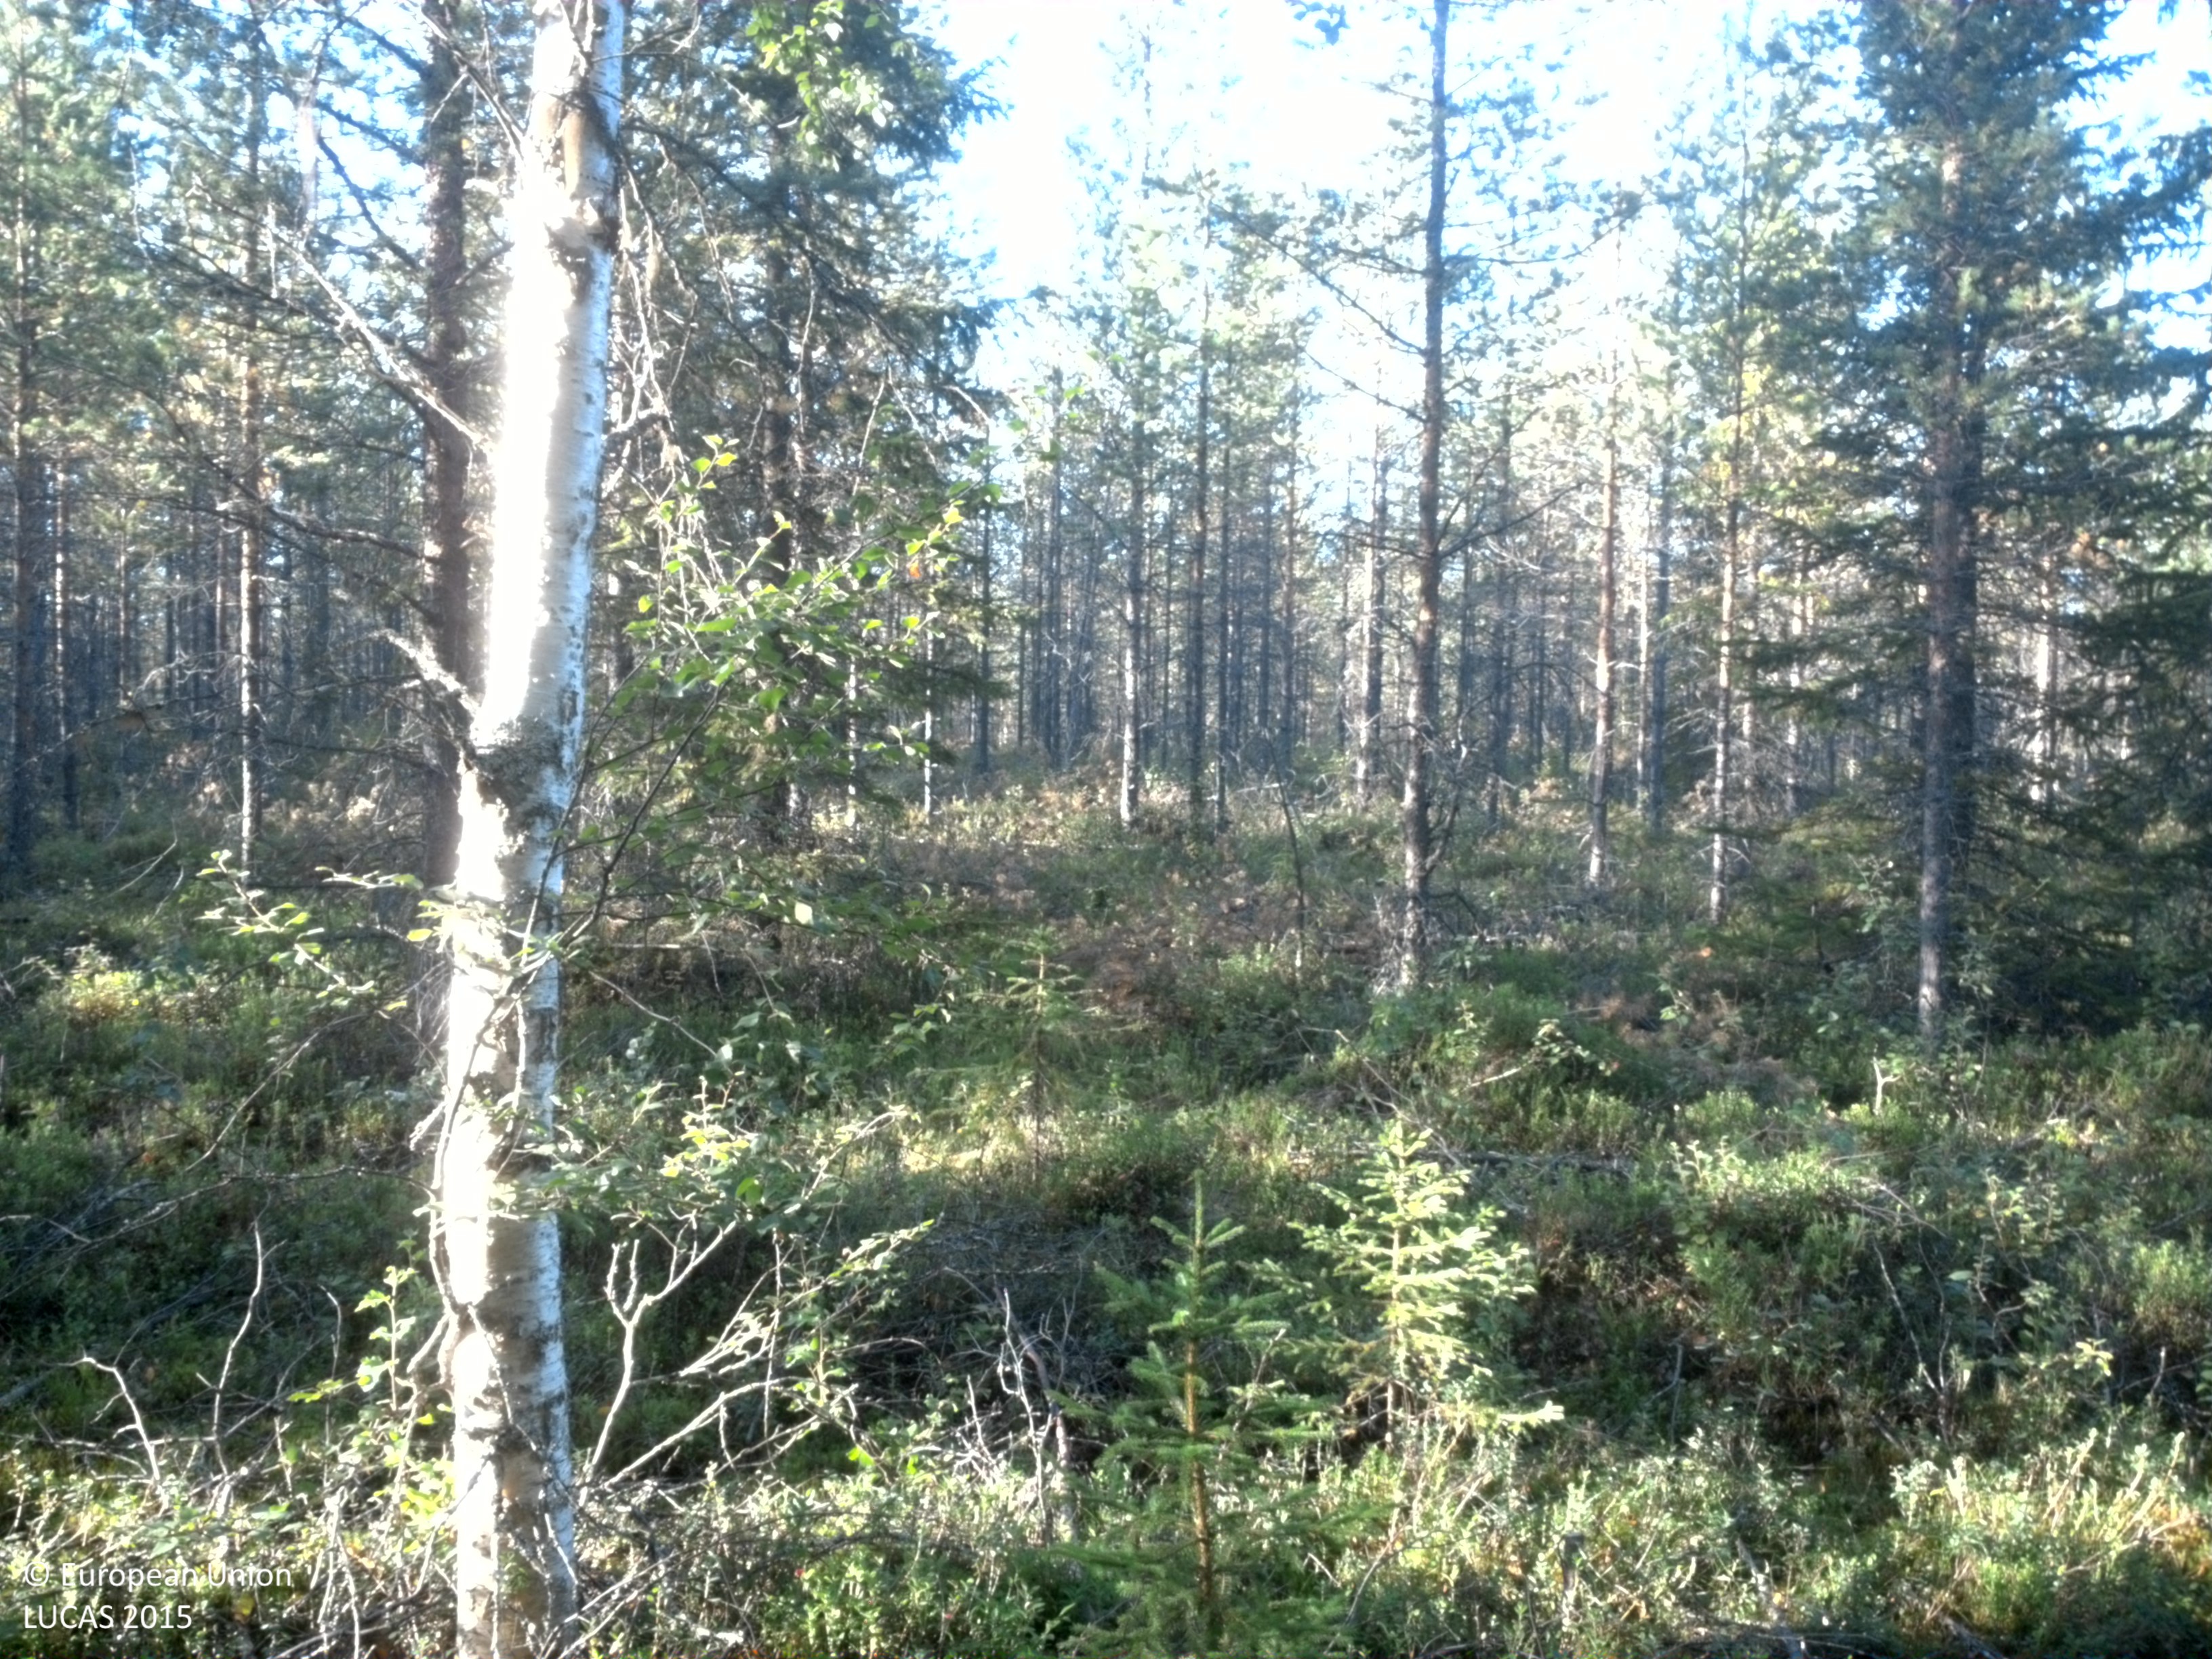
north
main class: Woodland
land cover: Pine dominated mixed woodland
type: boreal forest
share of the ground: 50 - 75 %
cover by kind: coniferous forest trees 45 %, shrubs 35 %, broadleaved forest trees 15 %, lichens and mosses 5 %
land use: Forestry
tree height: > 5 m
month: August
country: SE
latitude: 64.6165
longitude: 18.3092
